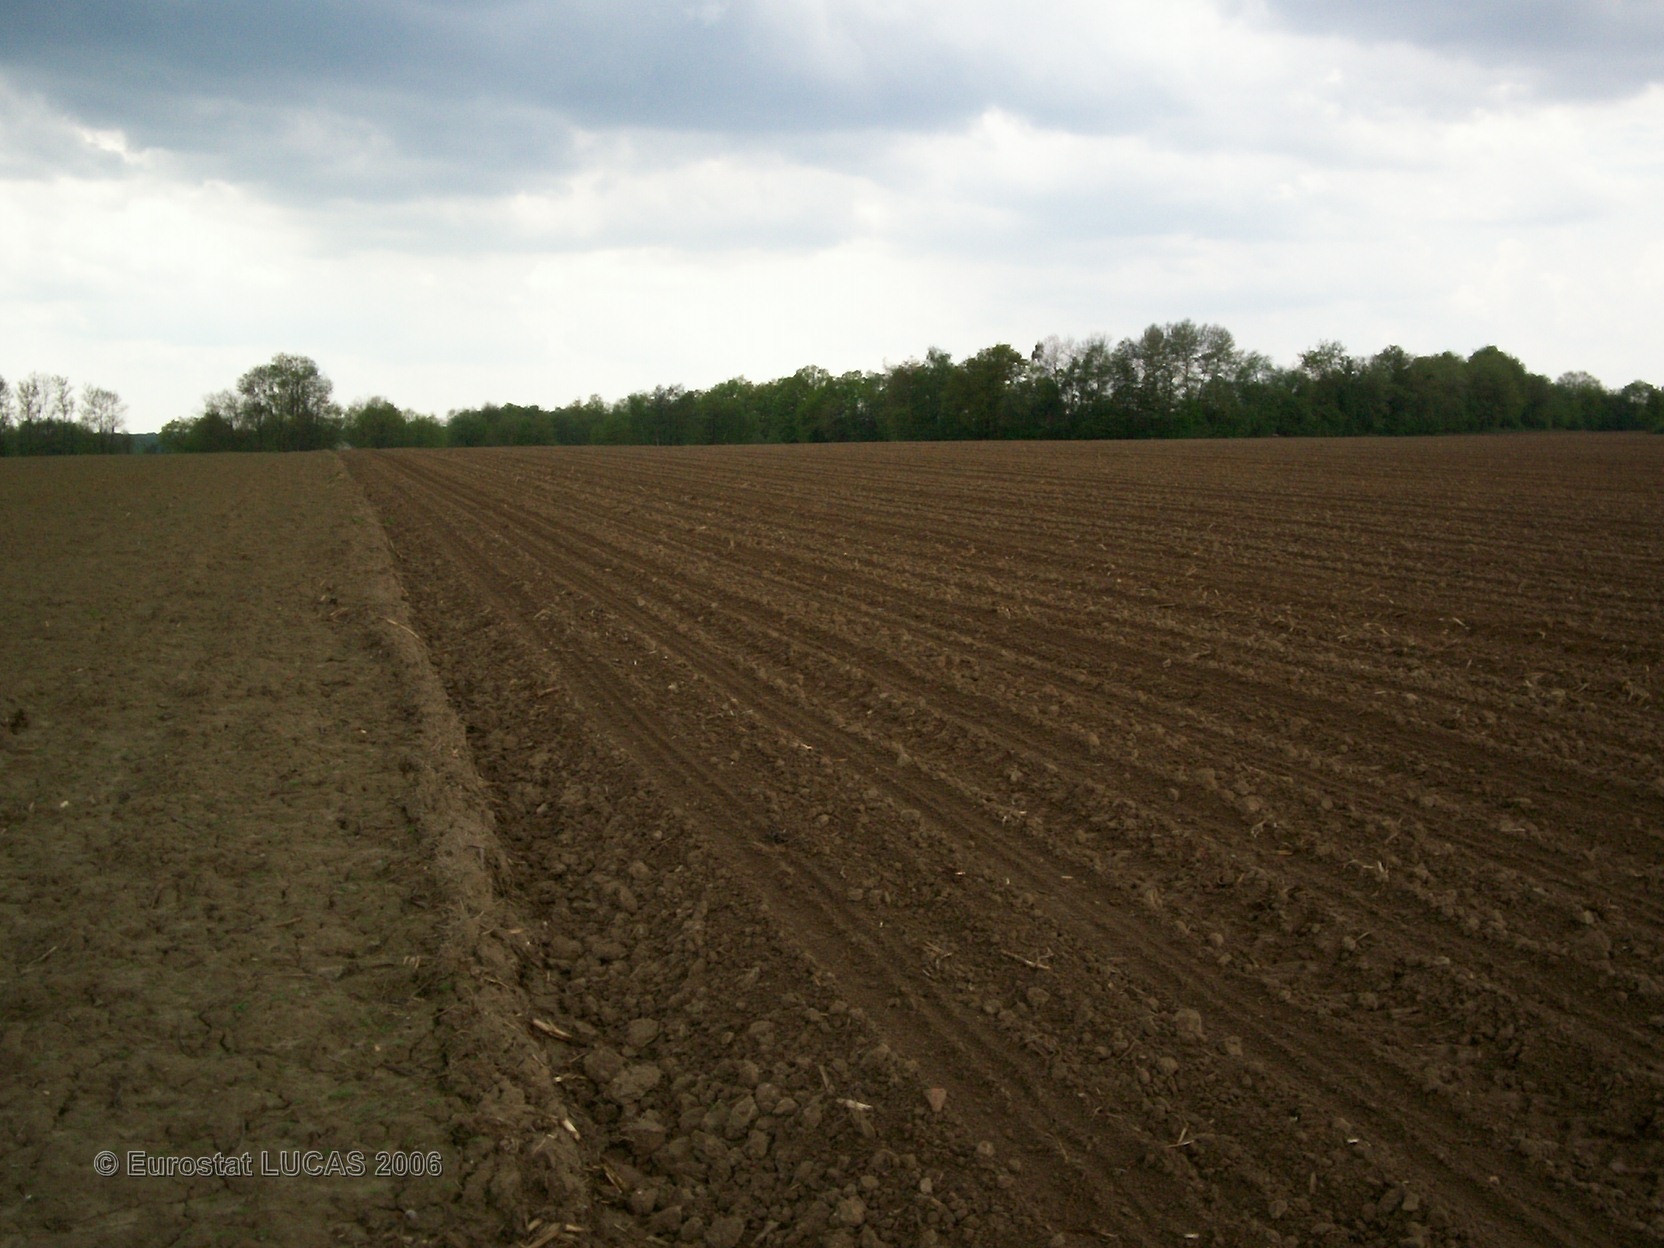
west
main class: Cropland
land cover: Maize
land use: Agriculture (excluding fallow land and kitchen gardens)
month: May
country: FR
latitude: 47.6426
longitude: 7.0065
